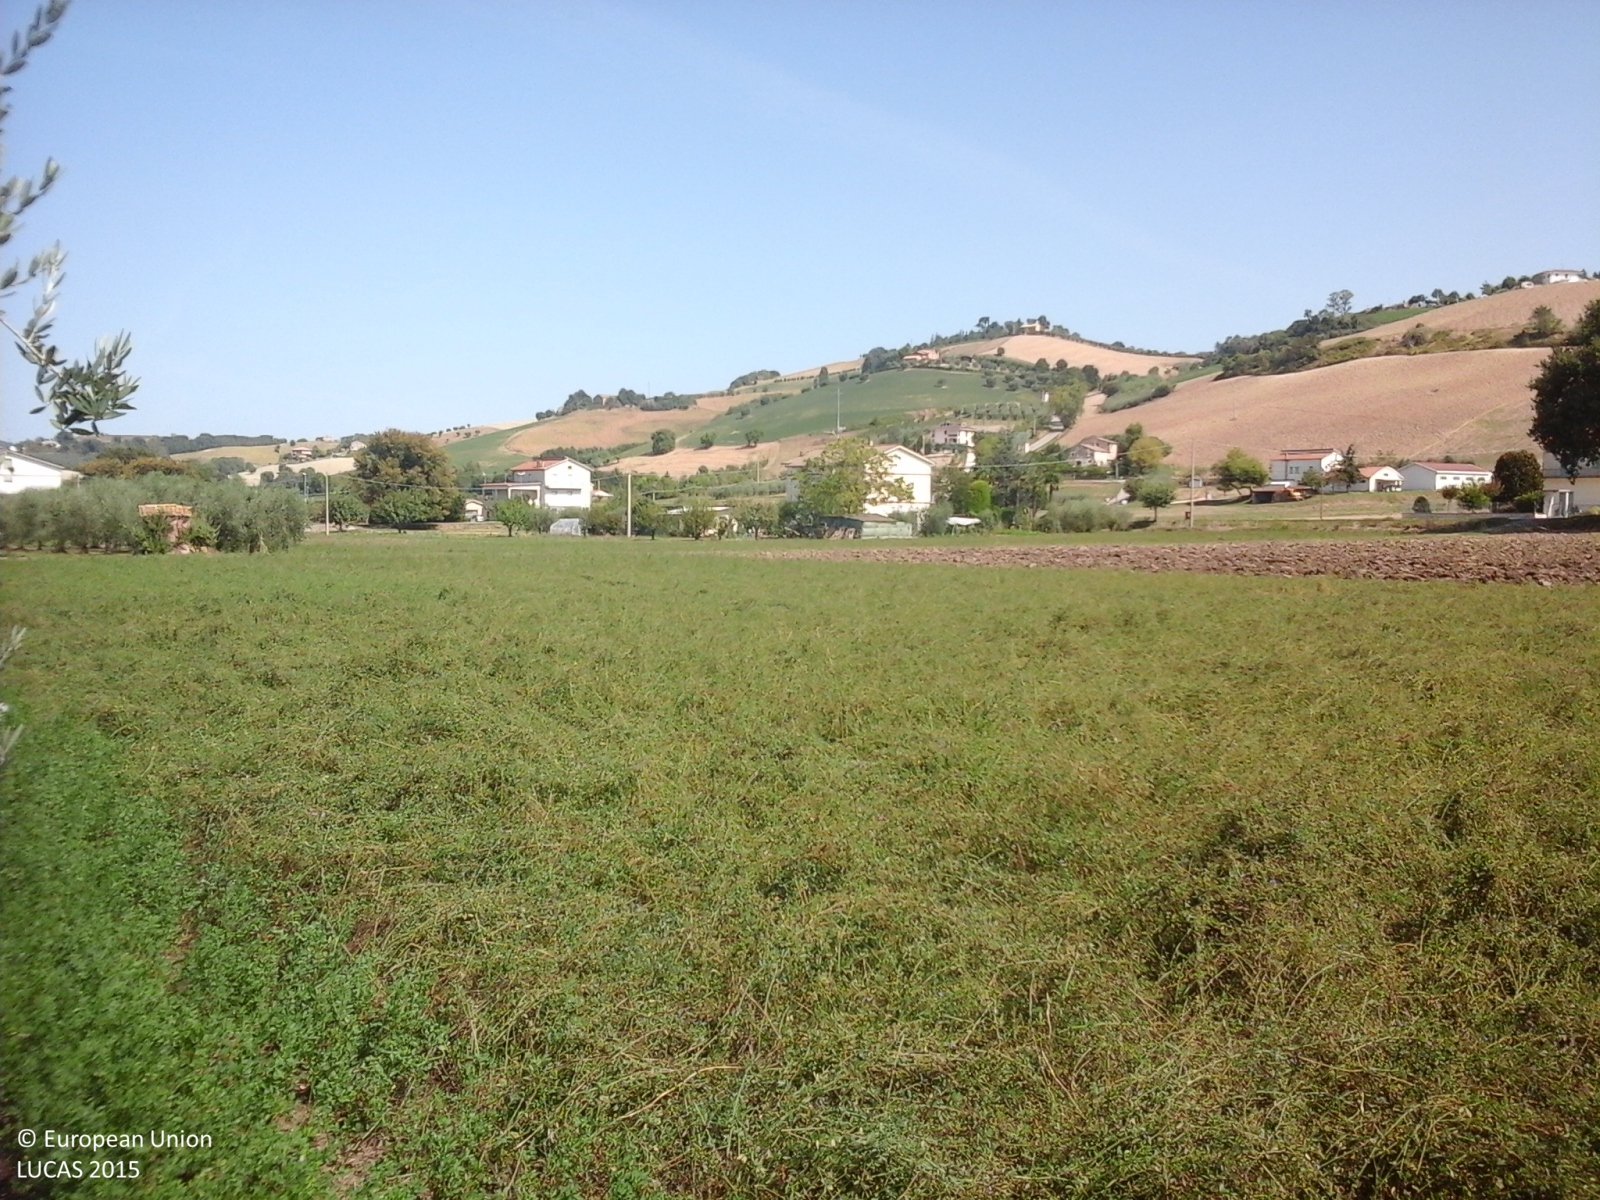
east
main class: Cropland
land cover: Olive groves
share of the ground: > 75 %
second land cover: Grassland without tree/shrub cover
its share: > 75 %
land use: Agriculture (excluding fallow land and kitchen gardens)
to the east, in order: Olive groves; Grassland without tree/shrub cover; Lucerne; Other bare soil; Grass margins; Tracks; Grass margins; Lucerne; Common wheat; Lines of trees; Common wheat; Other fresh vegetables; Artificial constructions in urban areas; Other fresh vegetables; Olive groves; Grass margins; Paved roads, cycling and walking lanes; Grass margins; Ditches and canals; Barley
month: August
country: IT
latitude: 43.1488
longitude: 13.6425
